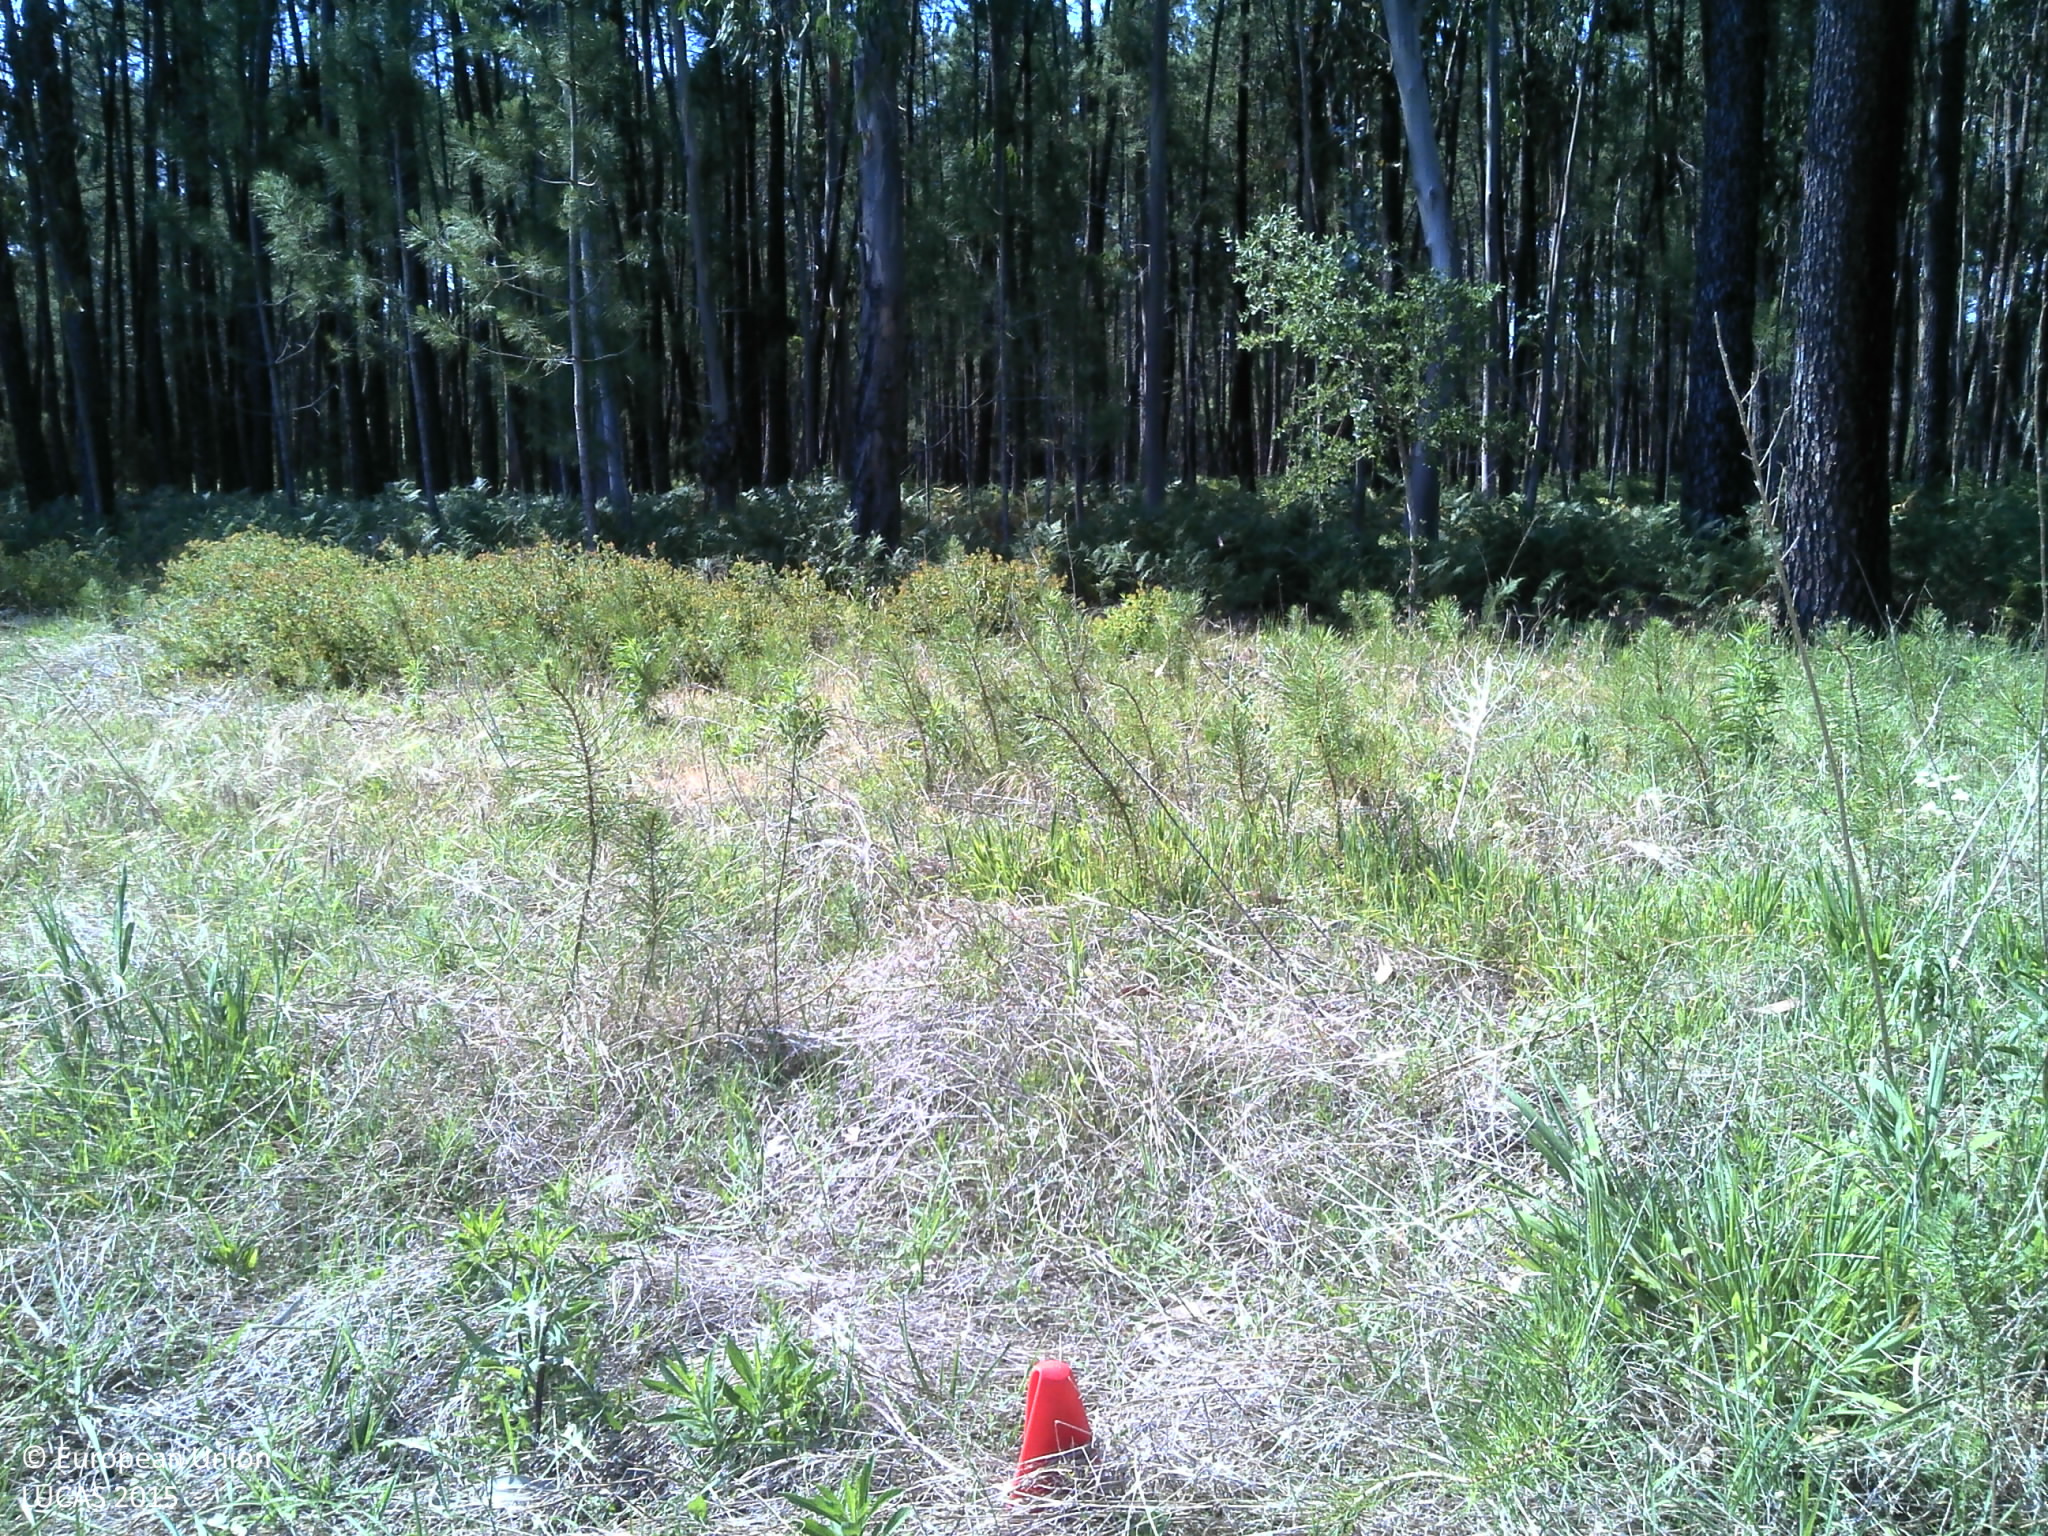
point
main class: Grassland
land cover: Spontaneously vegetated surfaces
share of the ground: 50 - 75 %
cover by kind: herbaceous plants 75 %, unconsolidated bare surface 25 %
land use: Fallow land
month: June
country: PT
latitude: 40.3469
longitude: -8.6587
